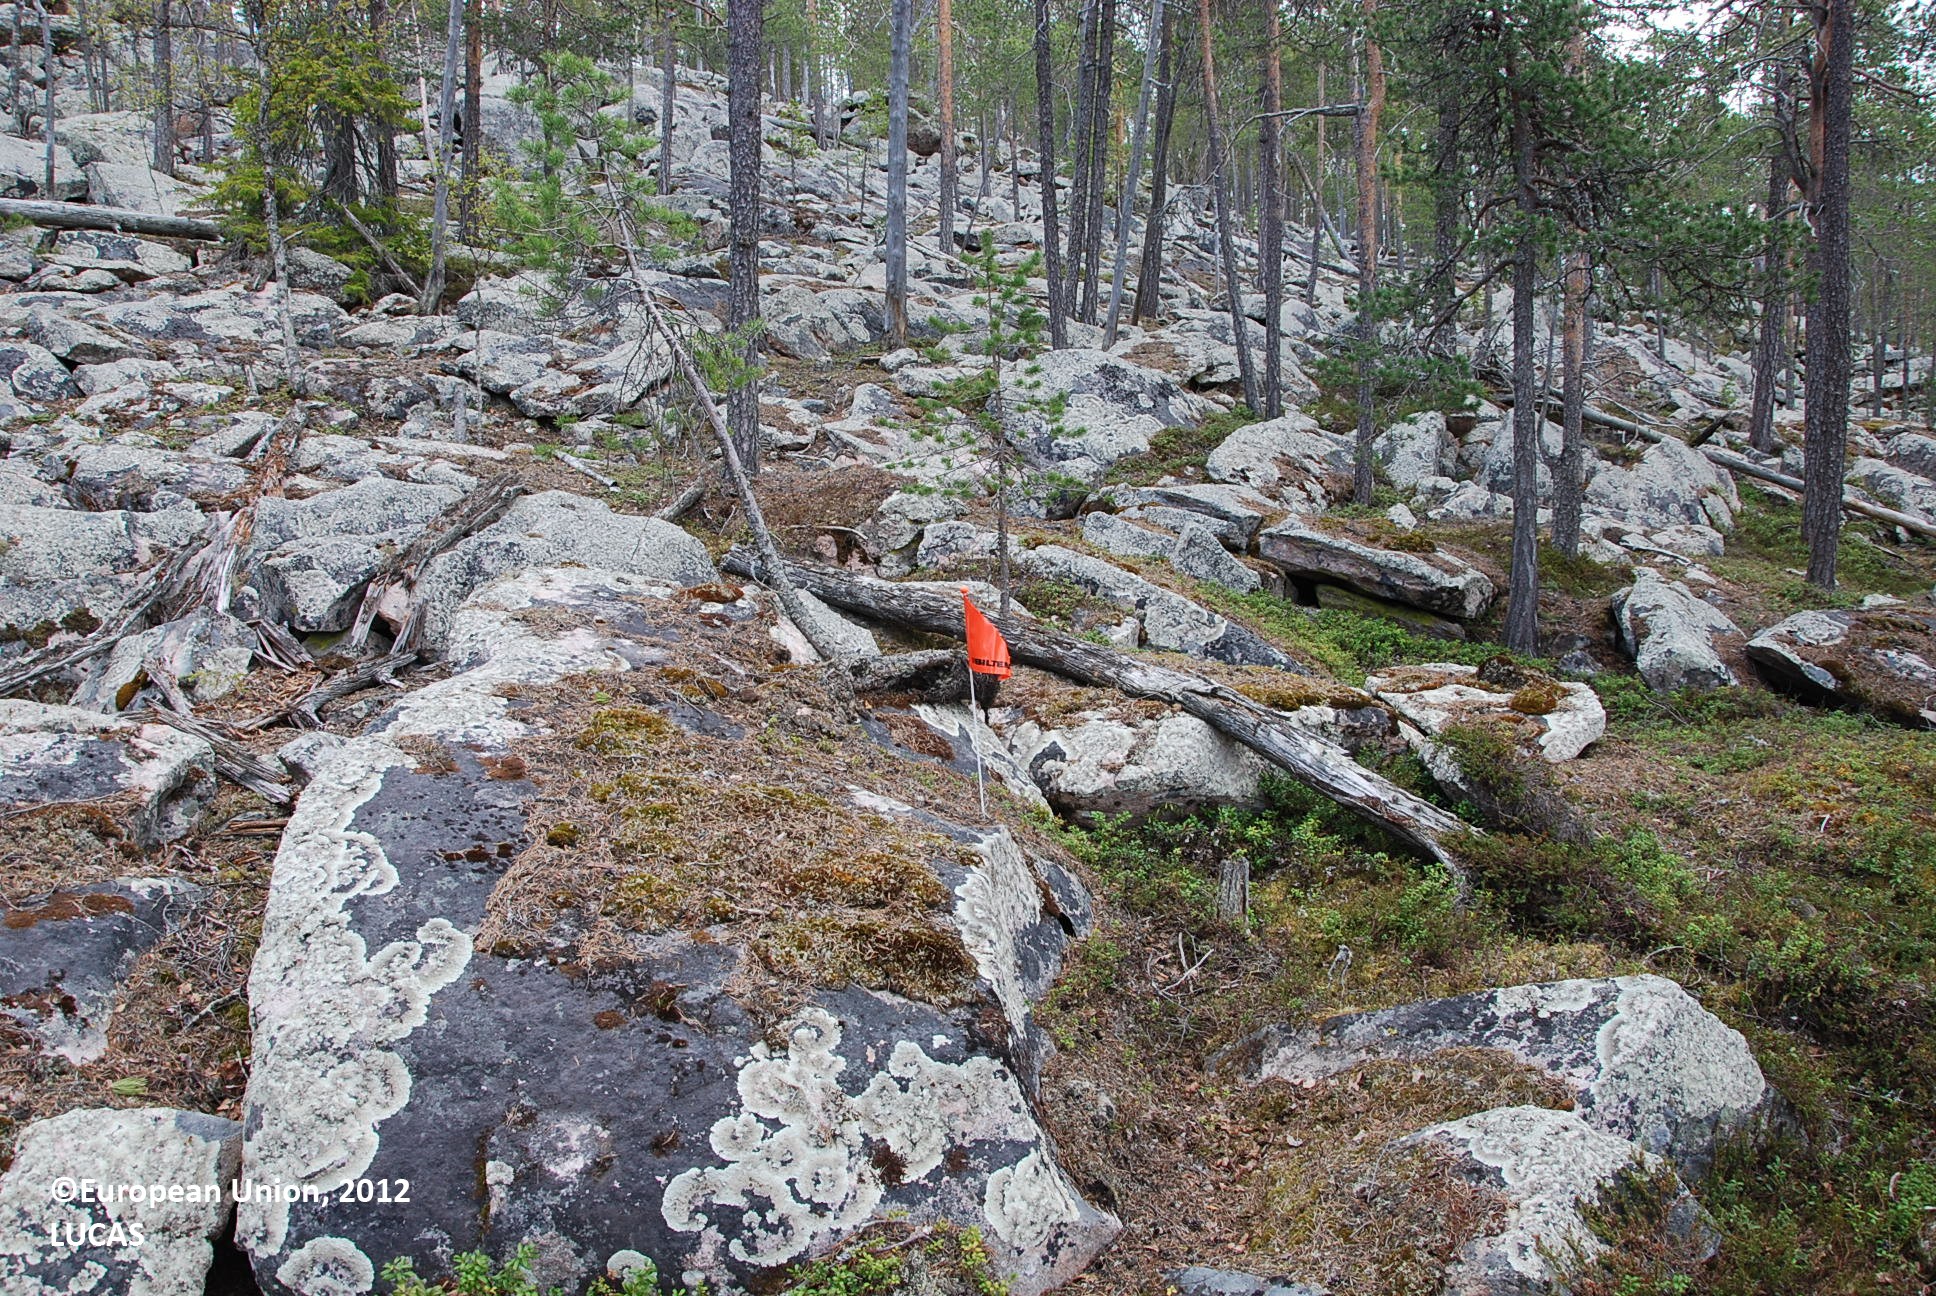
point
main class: Woodland
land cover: Pine dominated coniferous woodland
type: boreal forest
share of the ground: 25 - 50 %
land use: Forestry
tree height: > 5 m
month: May
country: FI
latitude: 66.8914
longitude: 28.2842
